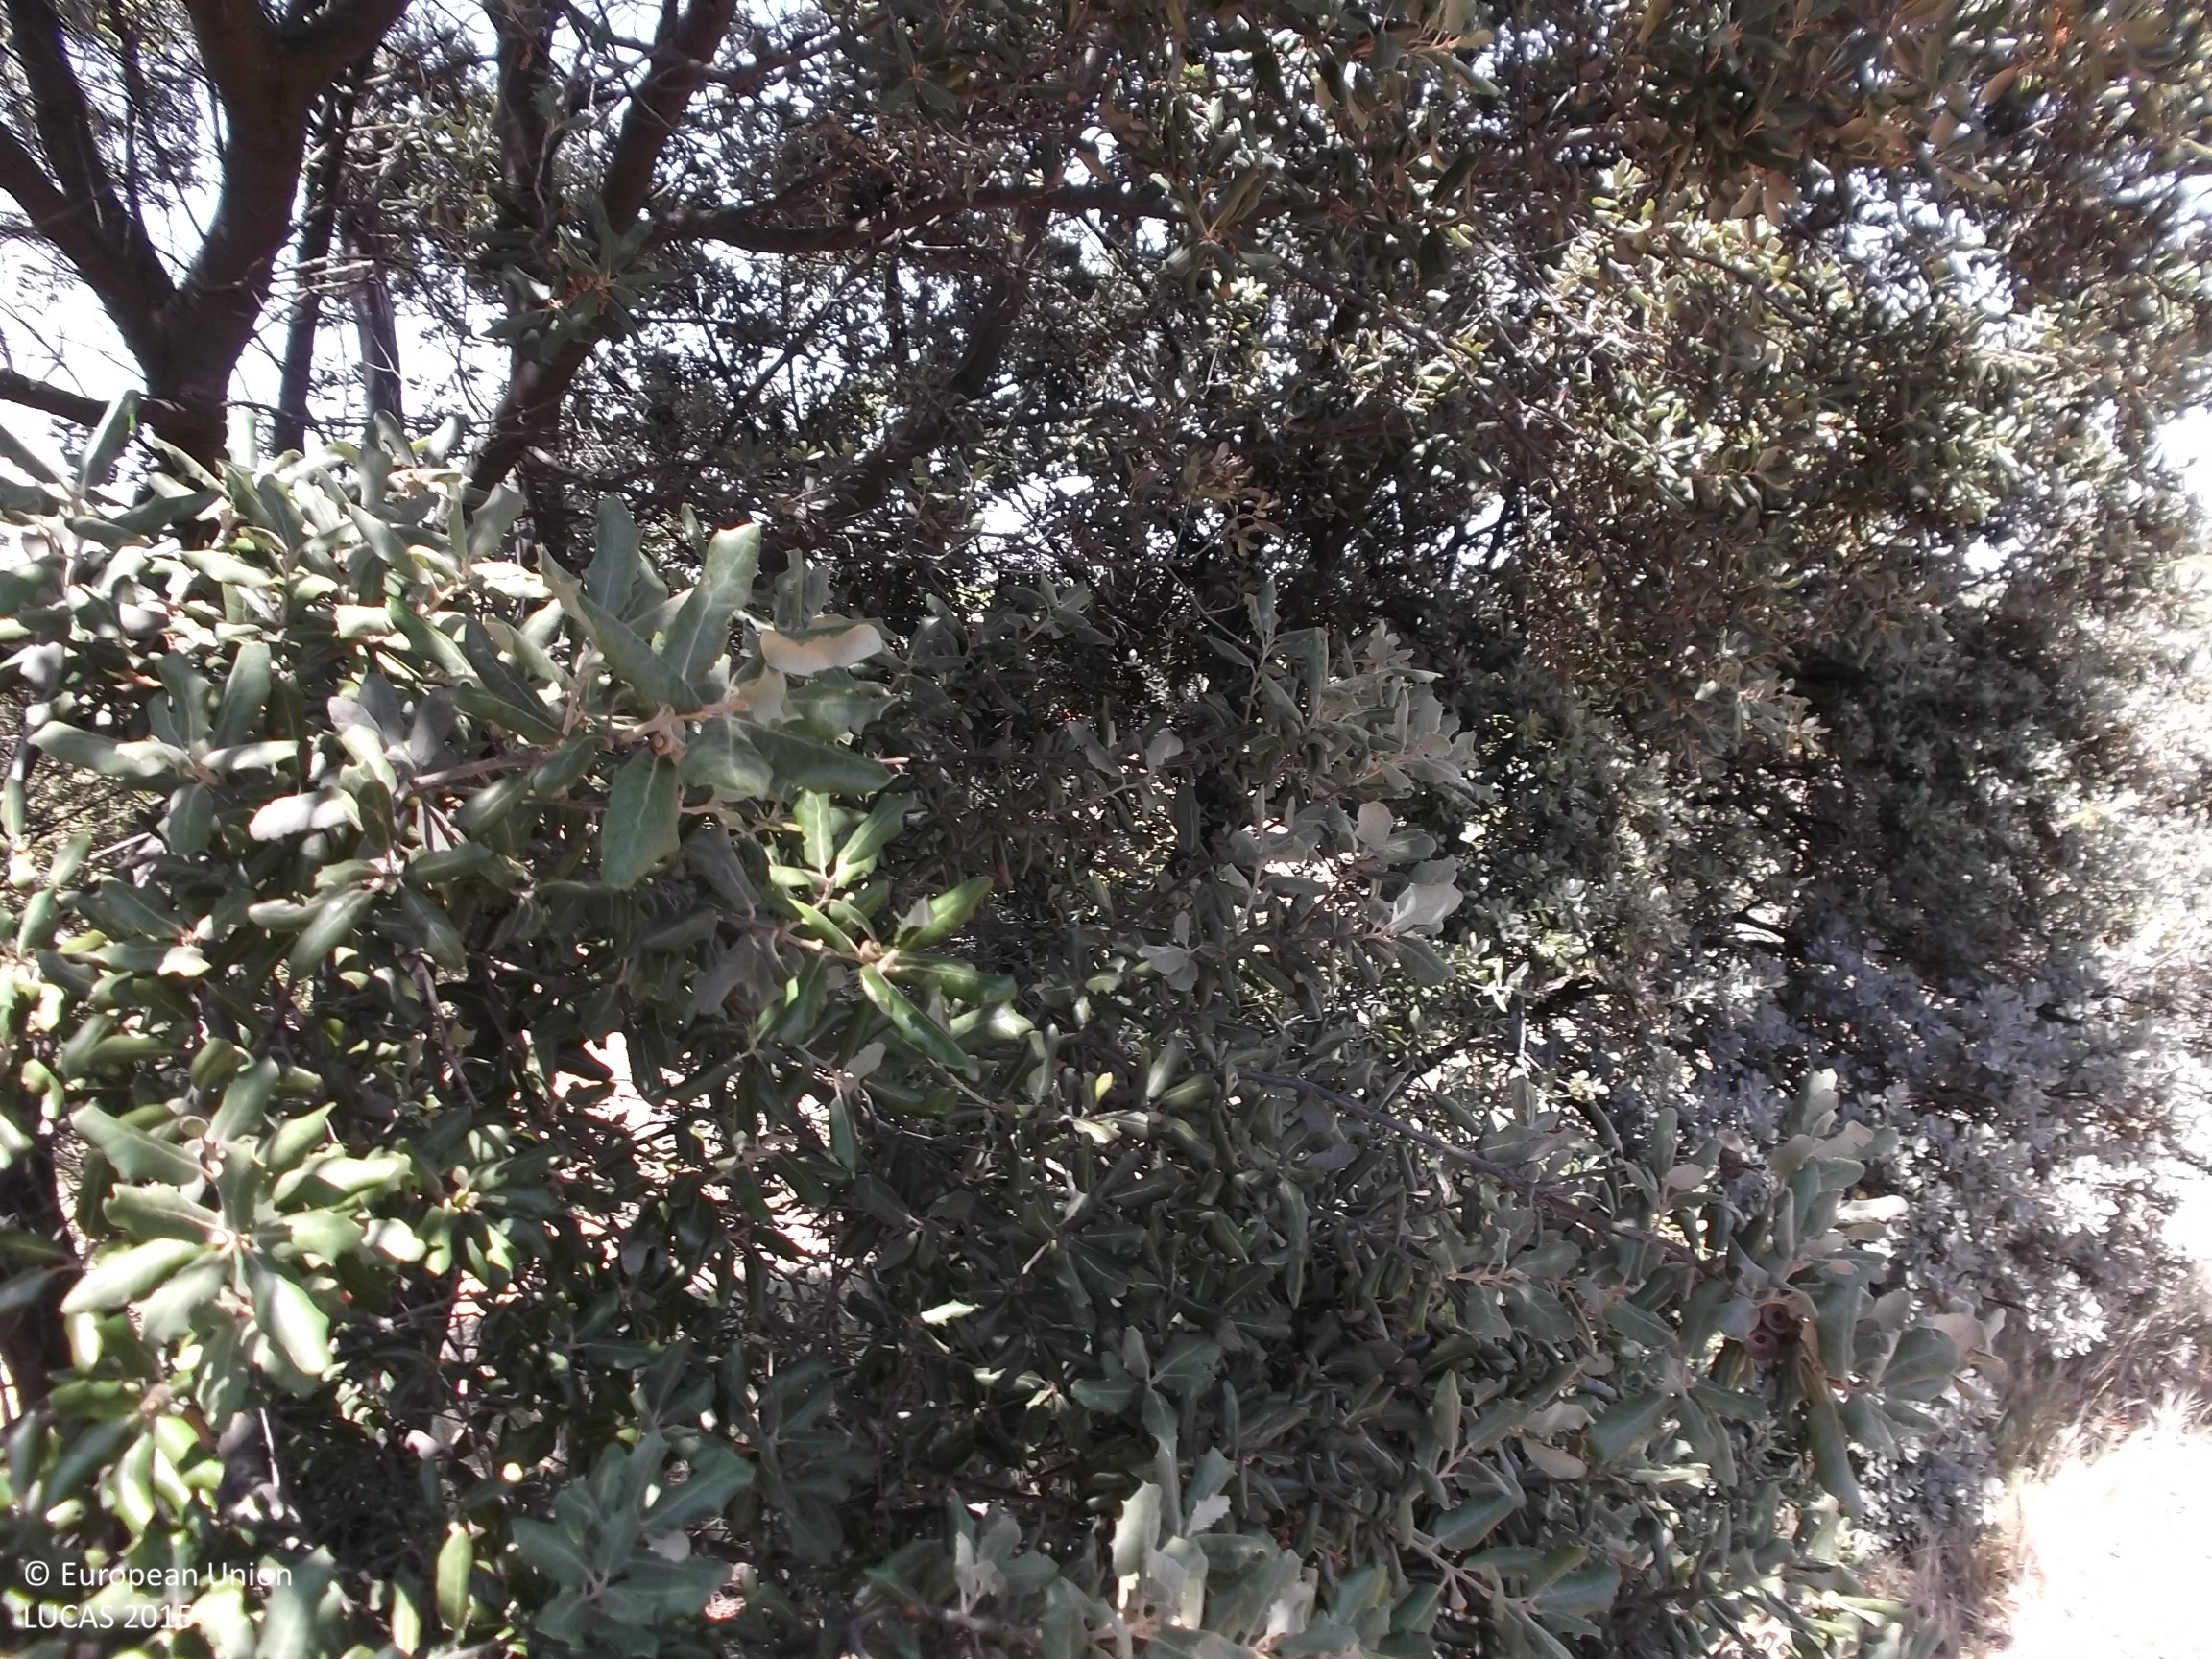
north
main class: Woodland
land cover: Broadleaved woodland
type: broadleaved evergreen forest
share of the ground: 10 - 25 %
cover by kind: herbaceous plants 60 %, shrubs 20 %, broadleaved forest trees 15 %, unconsolidated bare surface 5 %
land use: Semi-natural and natural areas not in use
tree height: > 5 m
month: July
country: ES
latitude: 42.1680
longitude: -2.0574
